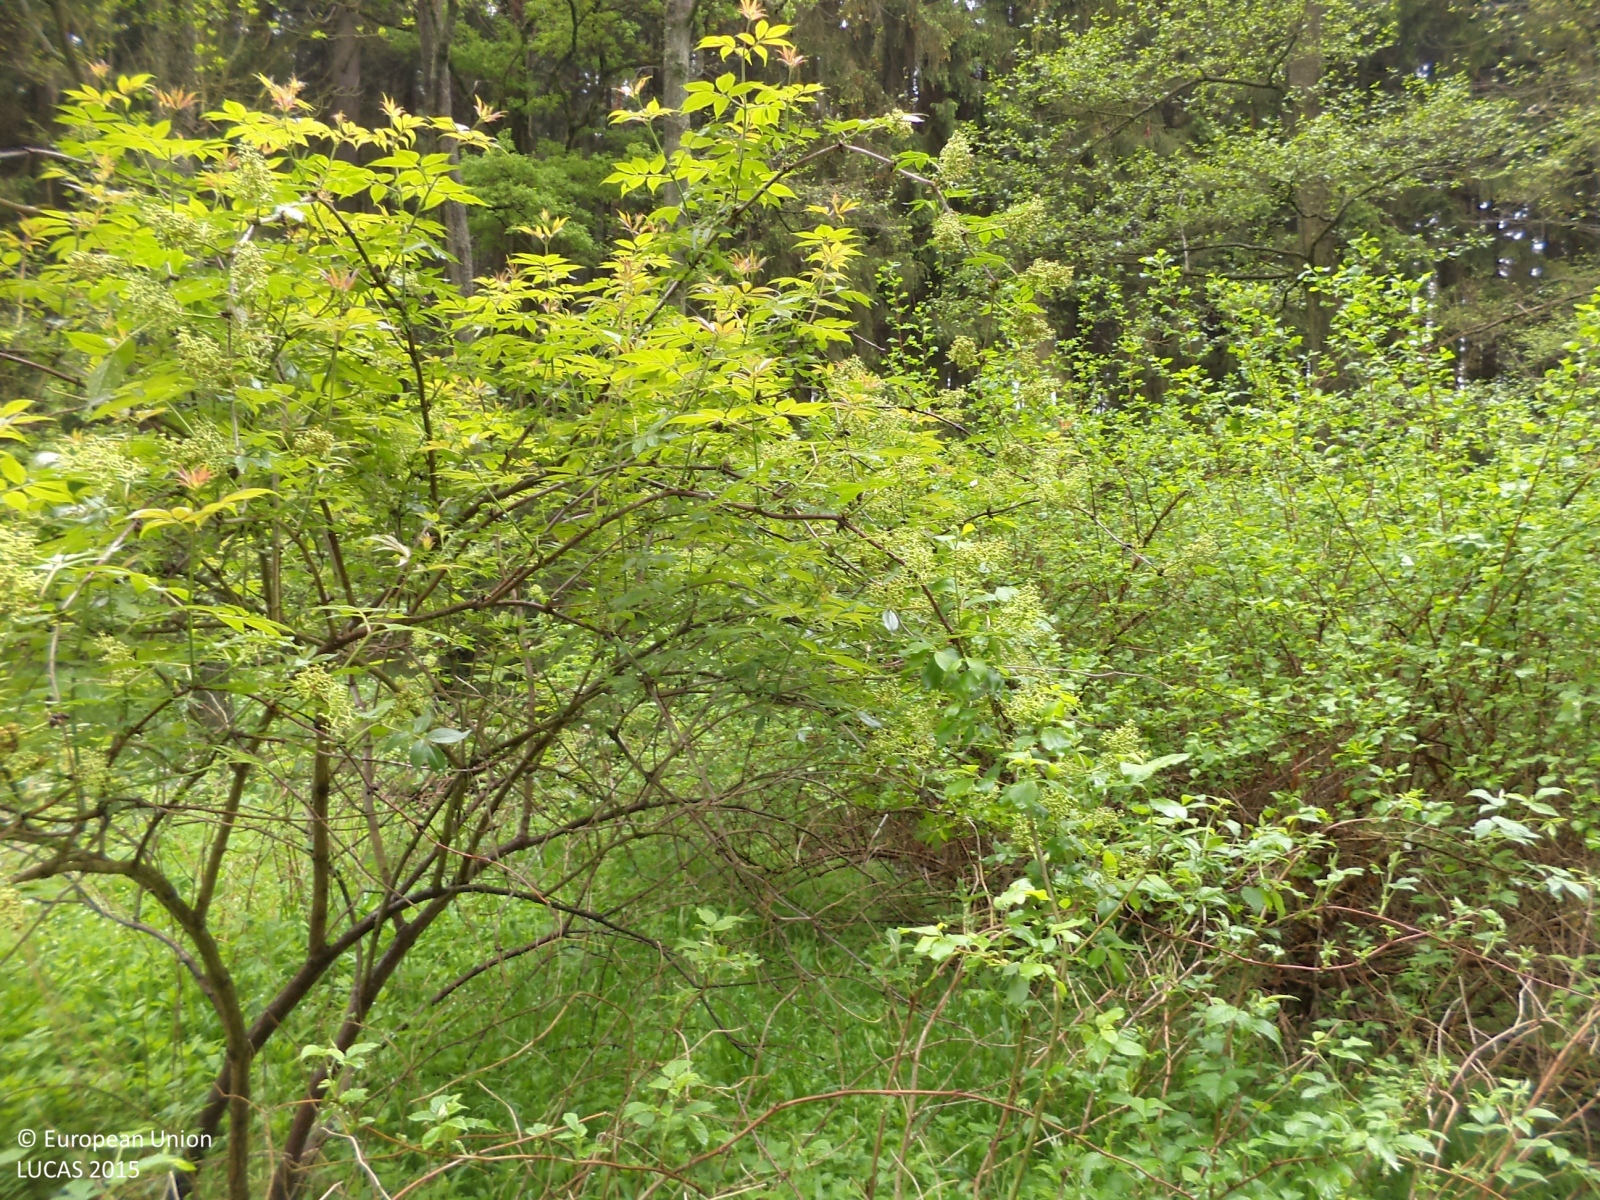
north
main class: Grassland
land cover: Grassland with sparse tree/shrub cover
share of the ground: > 75 %
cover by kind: herbaceous plants 90 %, broadleaved forest trees 5 %, shrubs 5 %
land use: Forestry
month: May
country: CZ
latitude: 49.4831
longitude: 14.9300
